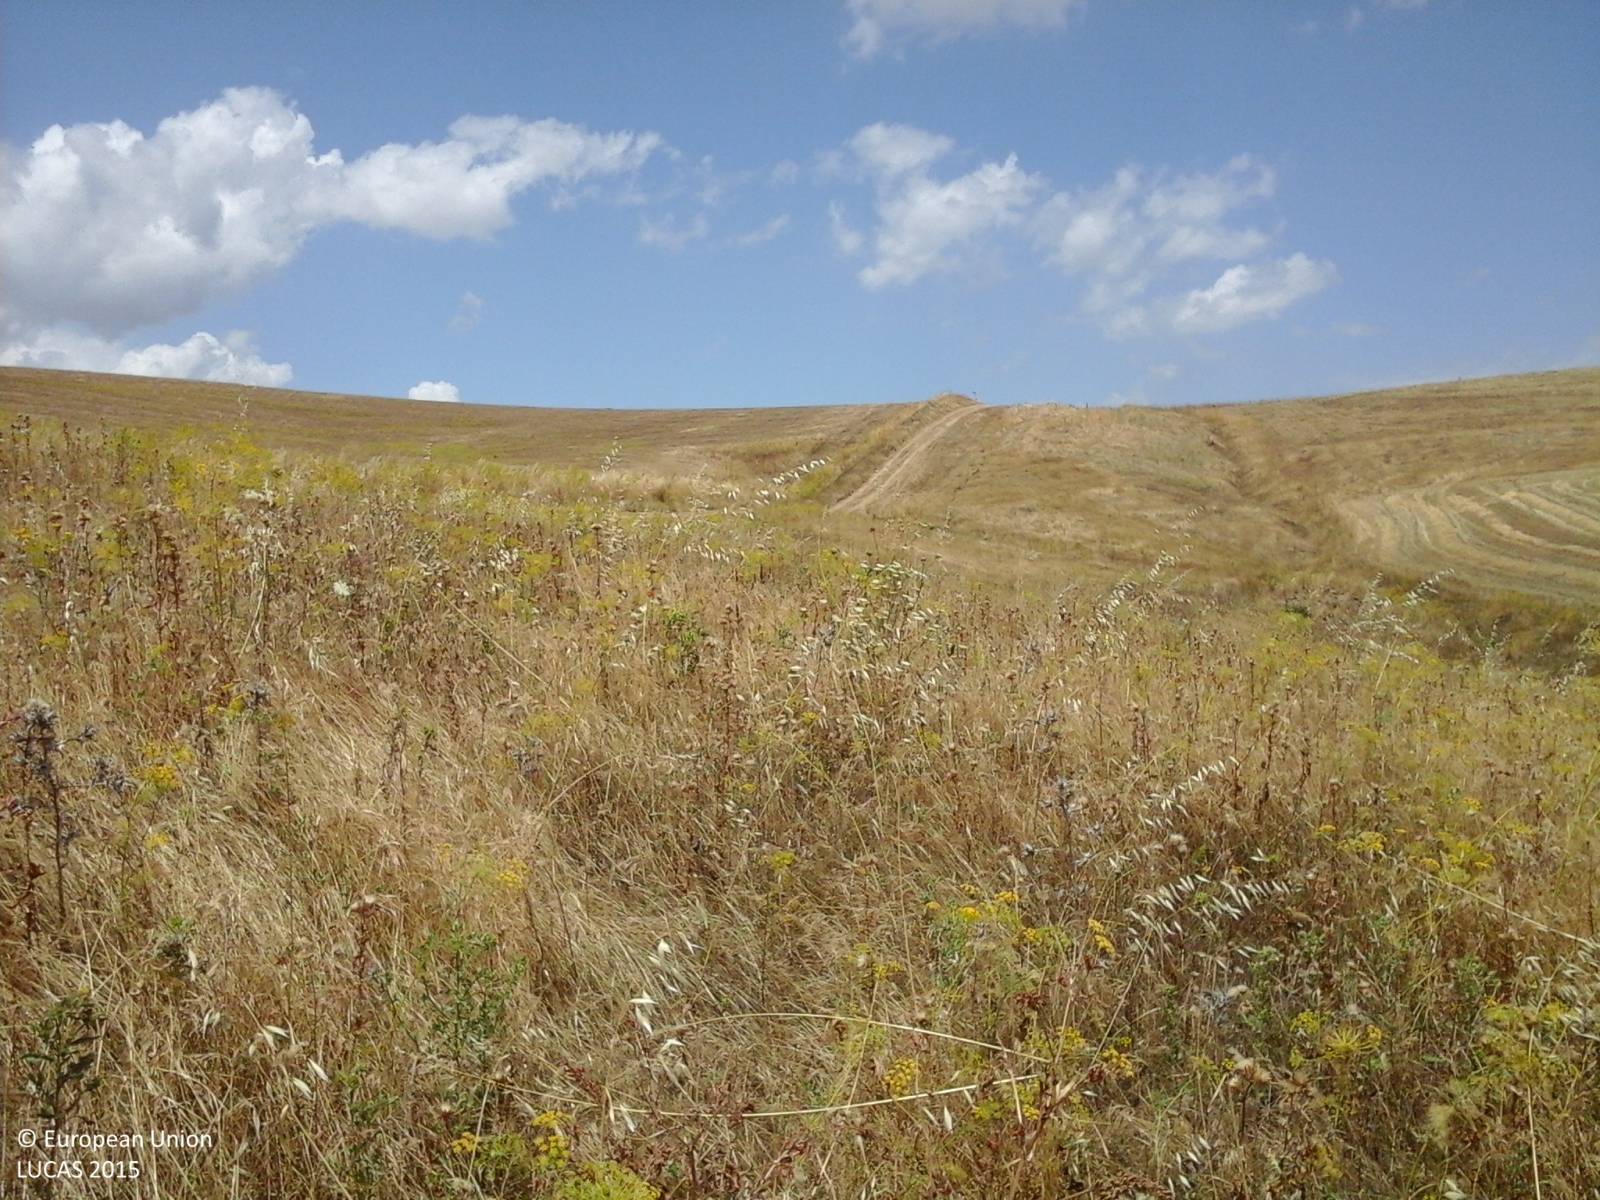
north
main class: Grassland
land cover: Grassland without tree/shrub cover
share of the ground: > 75 %
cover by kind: herbaceous plants 75 %, unconsolidated bare surface 25 %
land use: Agriculture (excluding fallow land and kitchen gardens)
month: June
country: IT
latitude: 37.5540
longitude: 14.4163
